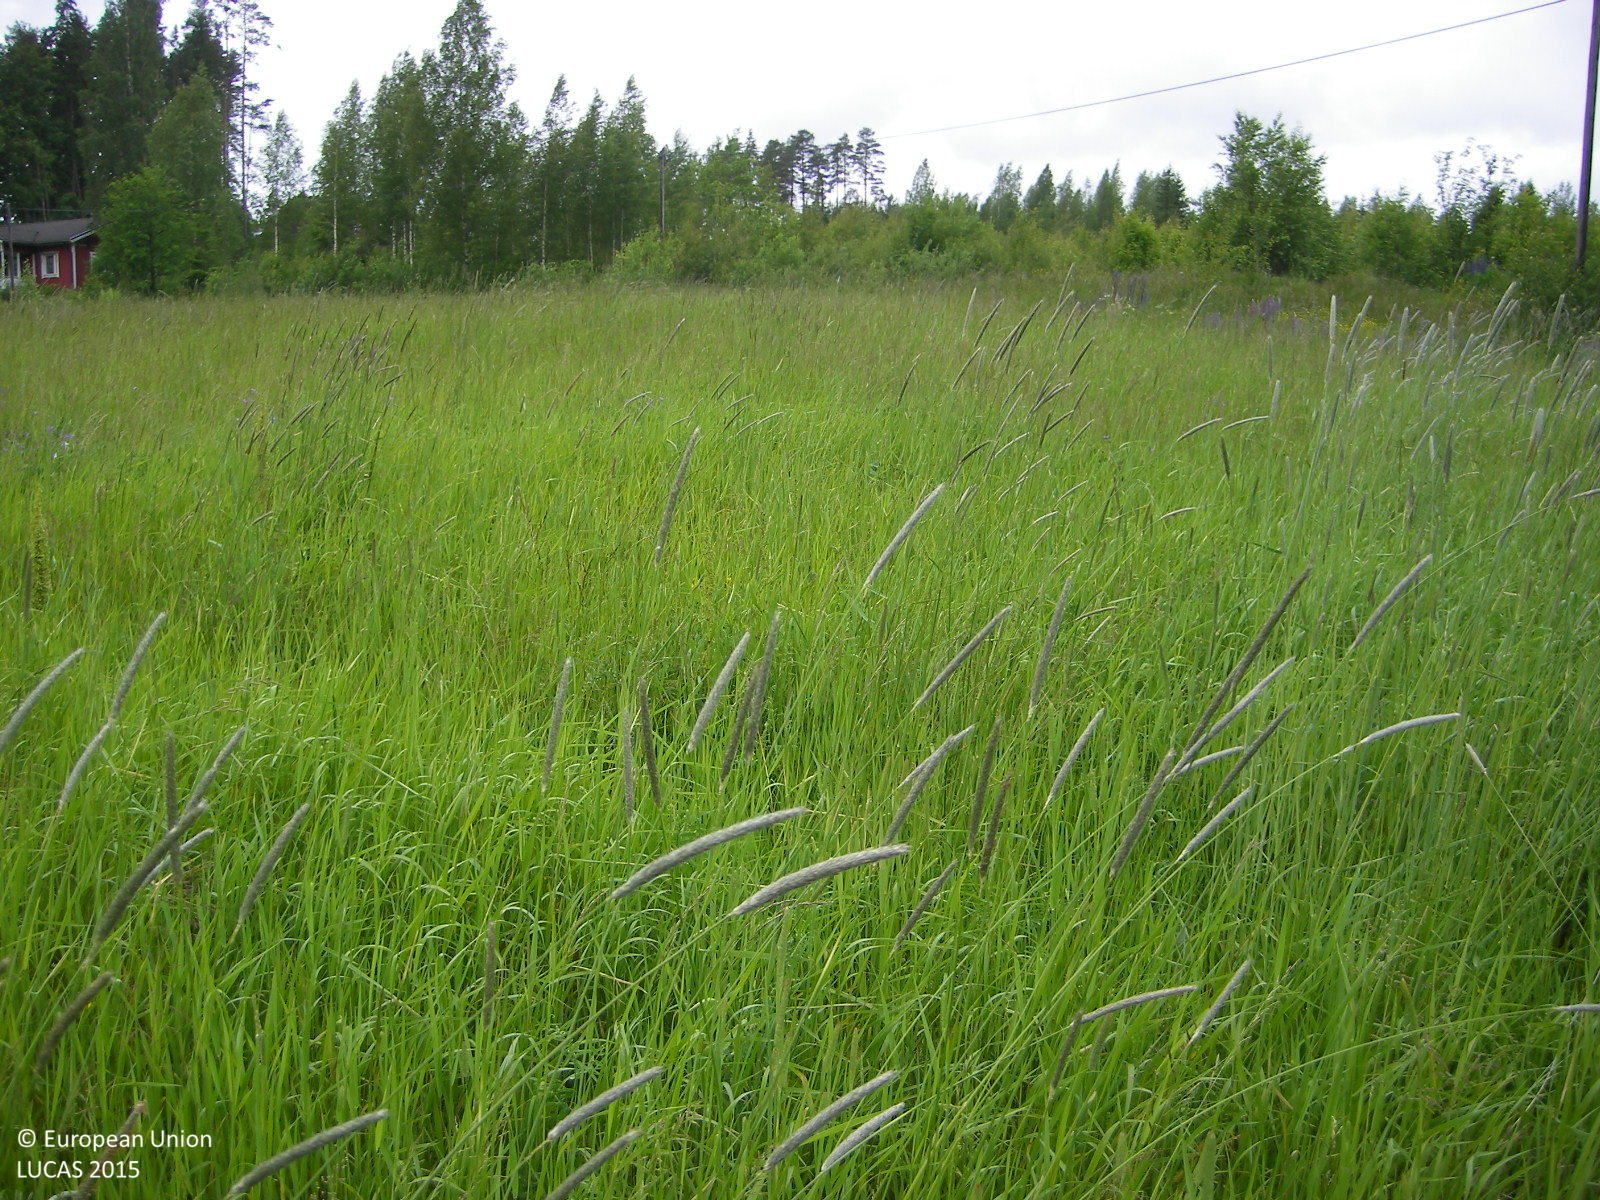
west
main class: Grassland
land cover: Grassland without tree/shrub cover
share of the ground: > 75 %
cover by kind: herbaceous plants 100 %
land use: Agriculture (excluding fallow land and kitchen gardens)
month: June
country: FI
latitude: 60.2081
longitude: 23.2745
